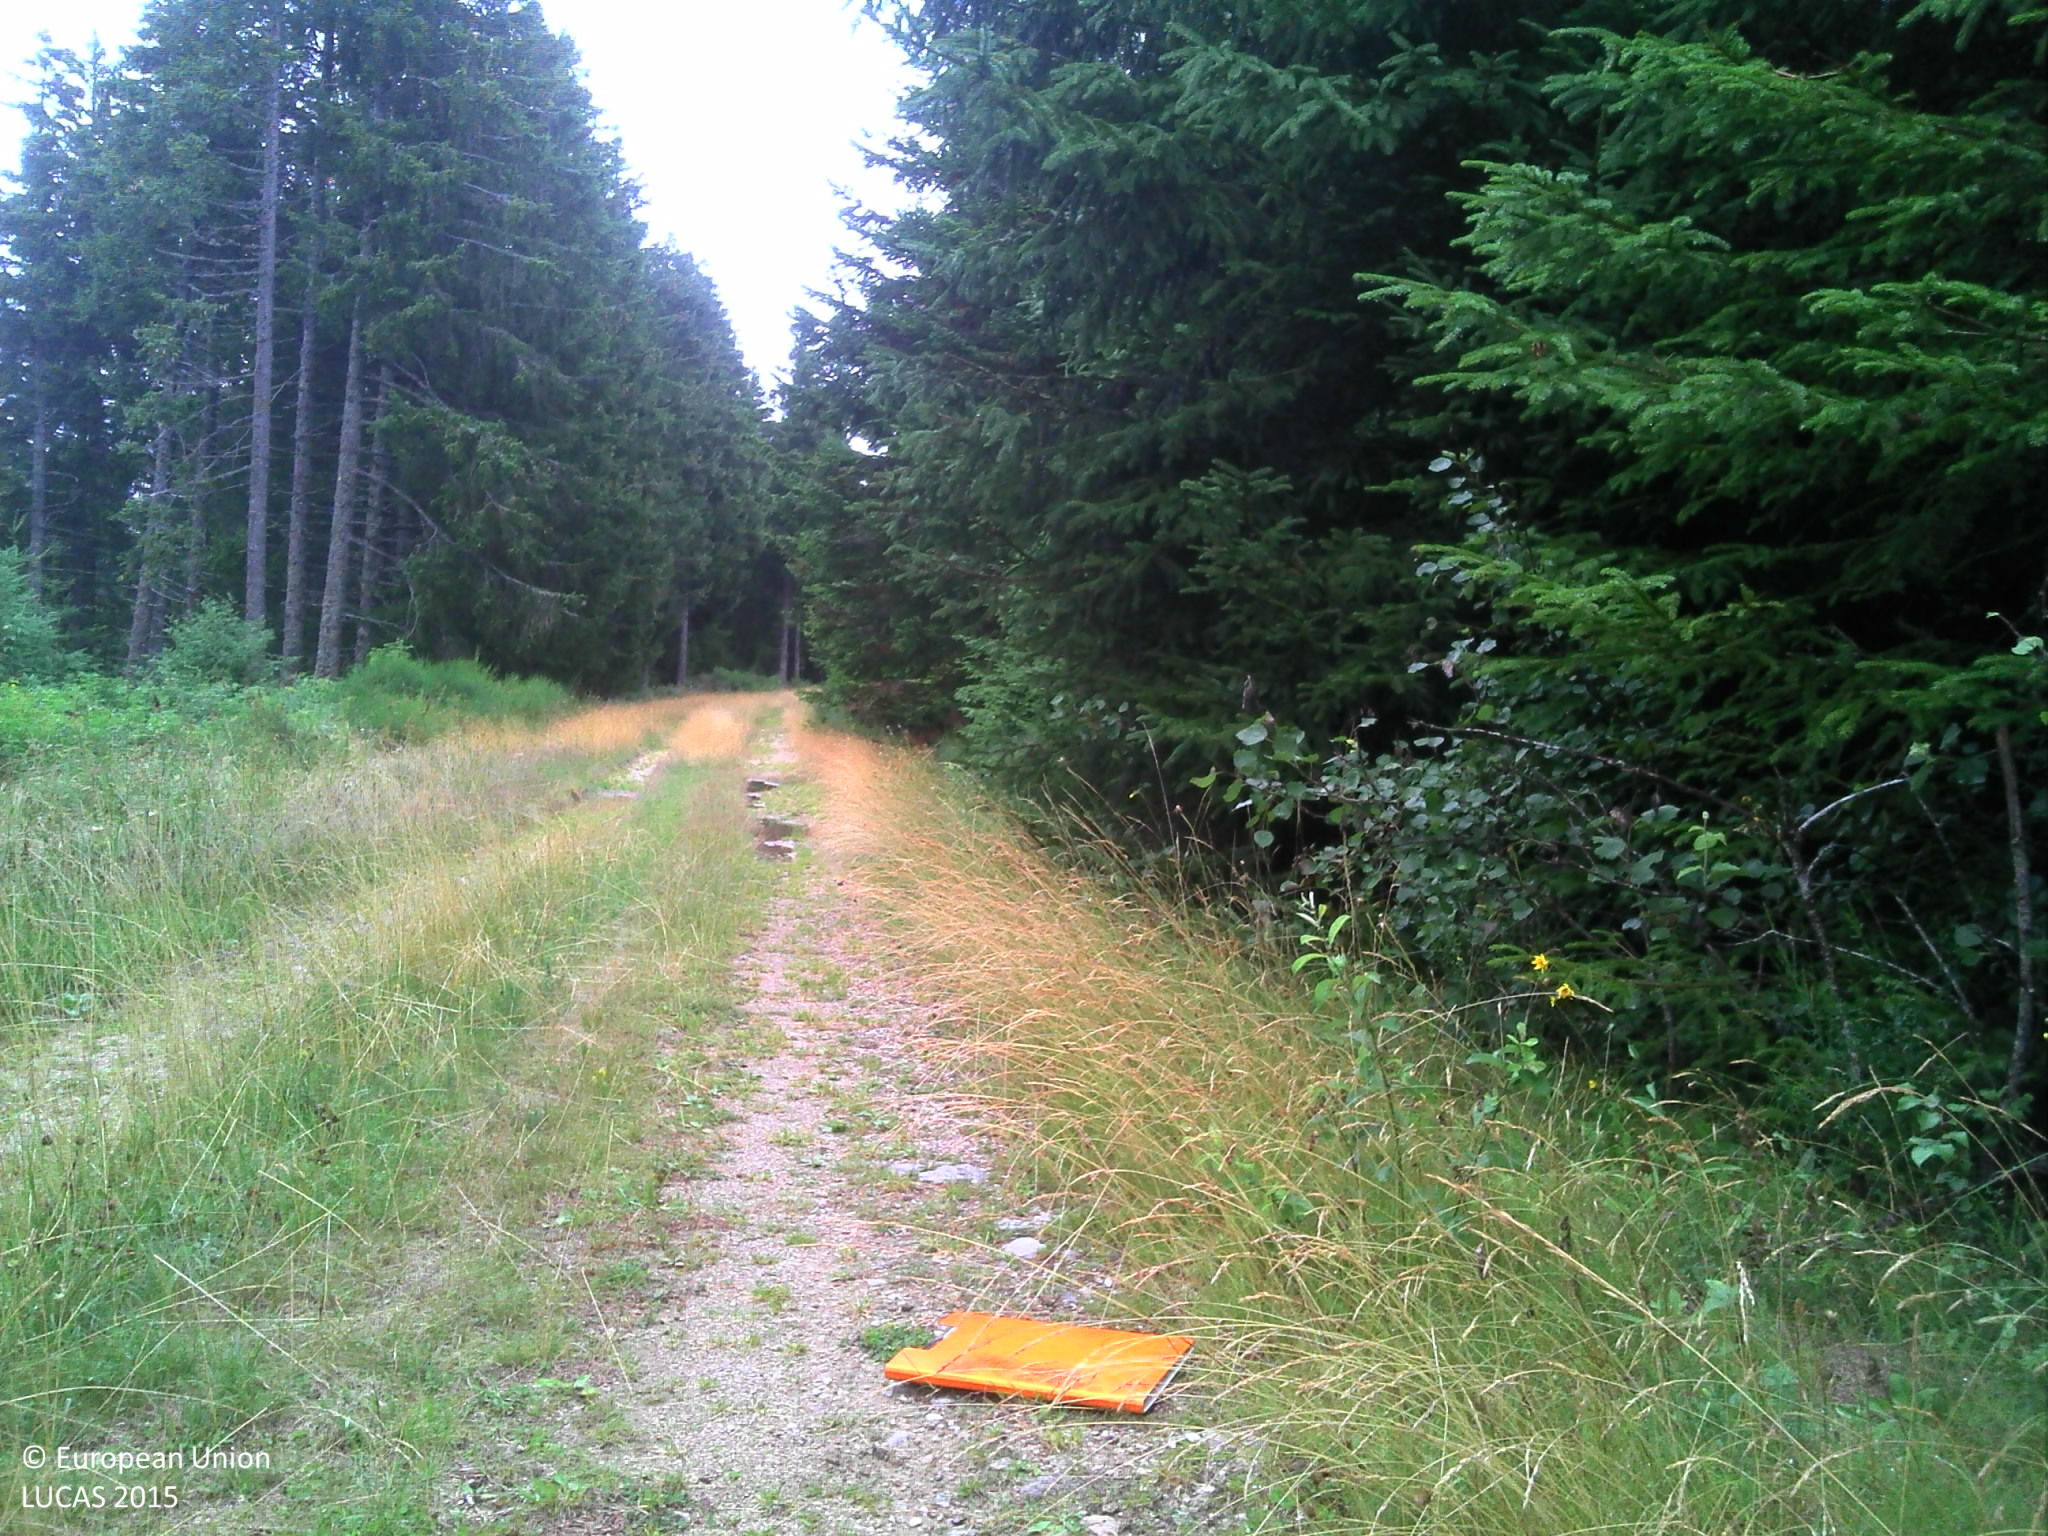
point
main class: Woodland
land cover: Spruce dominated coniferous woodland
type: alpine coniferous forest
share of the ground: > 75 %
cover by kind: coniferous forest trees 95 %, broadleaved forest trees 5 %
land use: Forestry
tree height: > 5 m
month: July
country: FR
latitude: 44.7451
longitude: 3.5252
